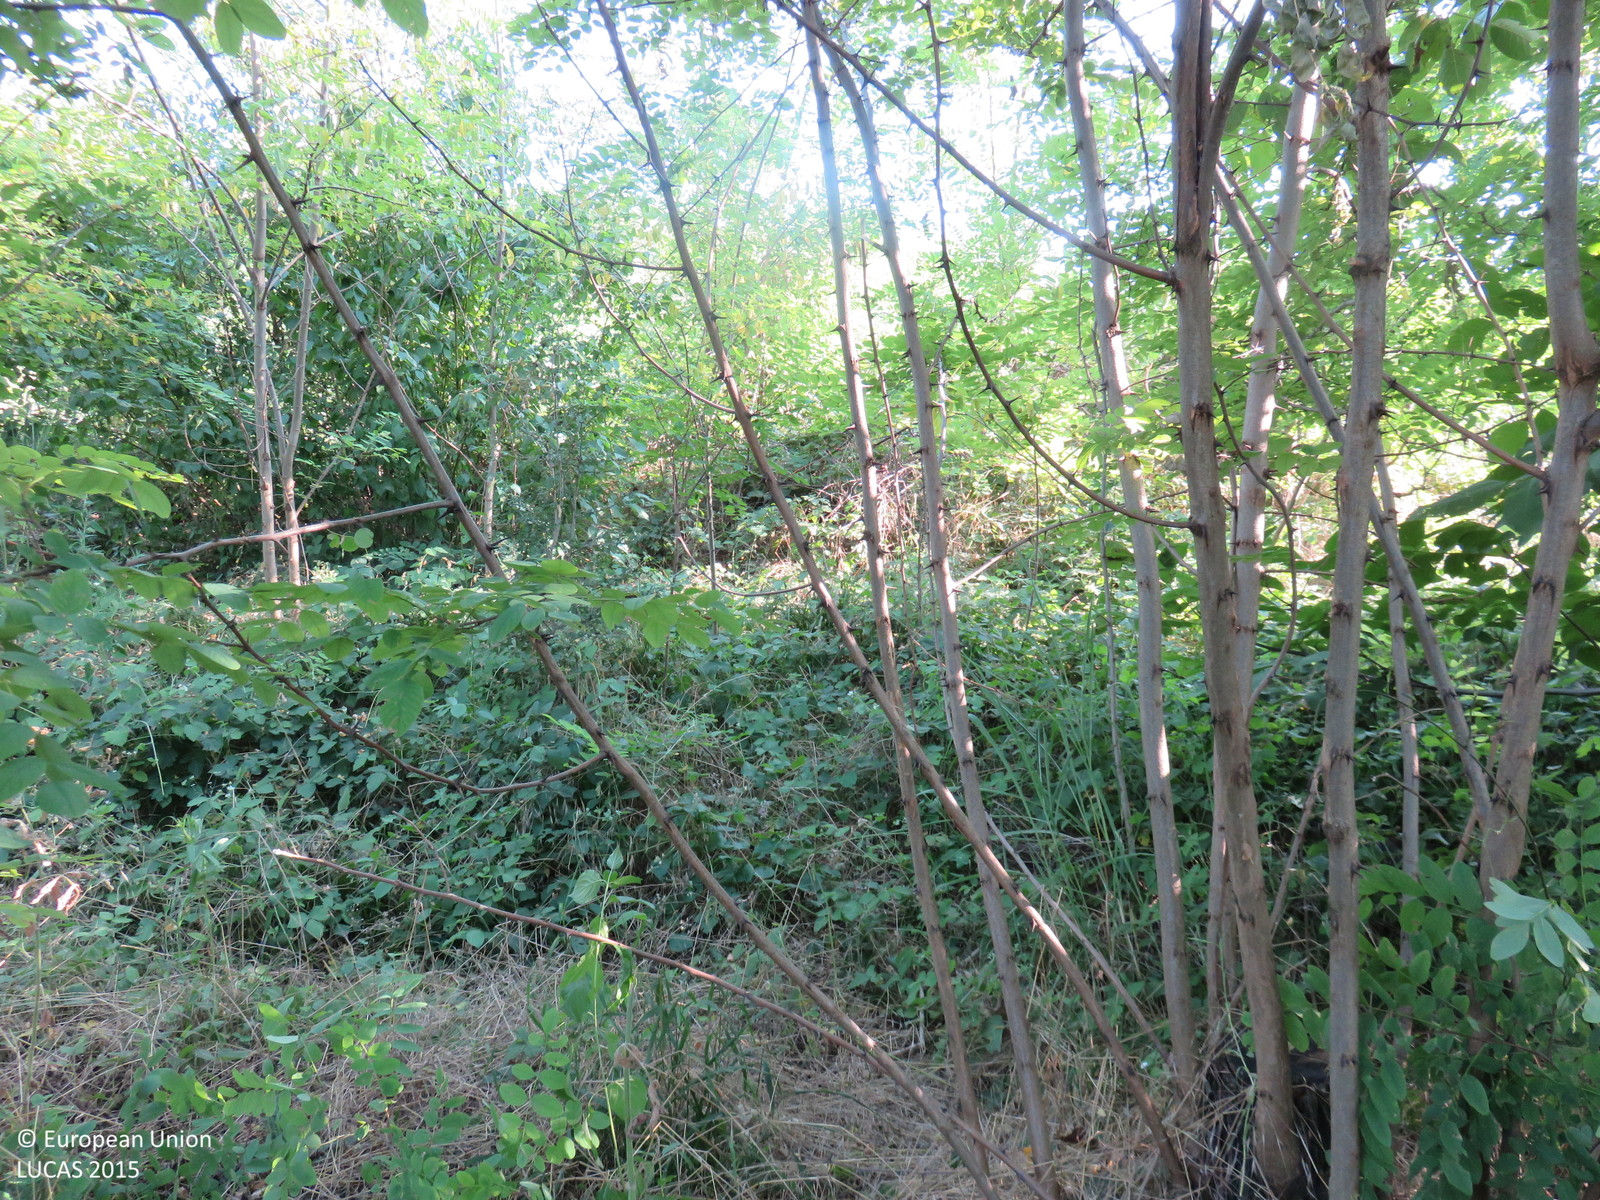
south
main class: Woodland
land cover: Broadleaved woodland
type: mesophytic deciduous forest
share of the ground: > 75 %
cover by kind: broadleaved forest trees 90 %, shrubs 5 %, herbaceous plants 5 %
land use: Forestry
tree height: < 5 m
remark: Clear cut
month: July
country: BG
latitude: 43.4880
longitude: 25.0208
